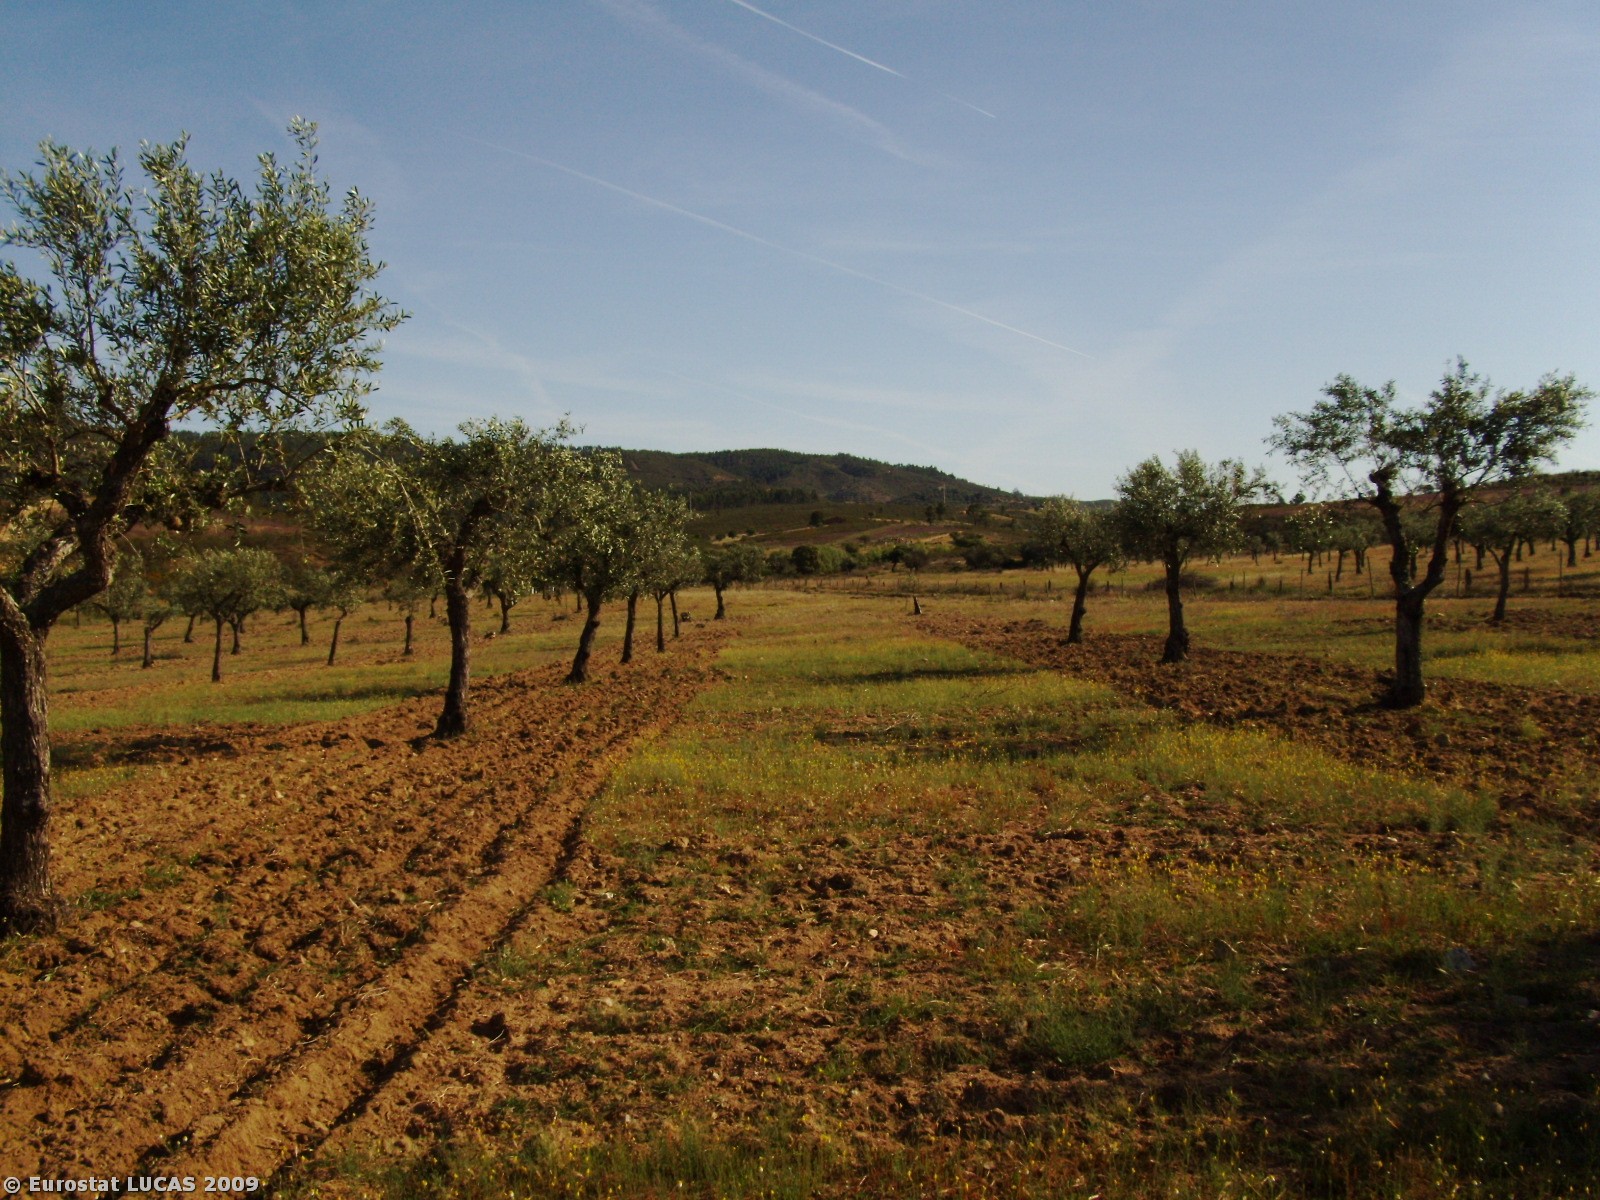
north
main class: Cropland
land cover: Olive groves
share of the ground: 10 - 25 %
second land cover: Spontaneously vegetated surfaces
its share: > 75 %
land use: Agriculture (excluding fallow land and kitchen gardens)
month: May
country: PT
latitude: 39.6996
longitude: -7.5808
